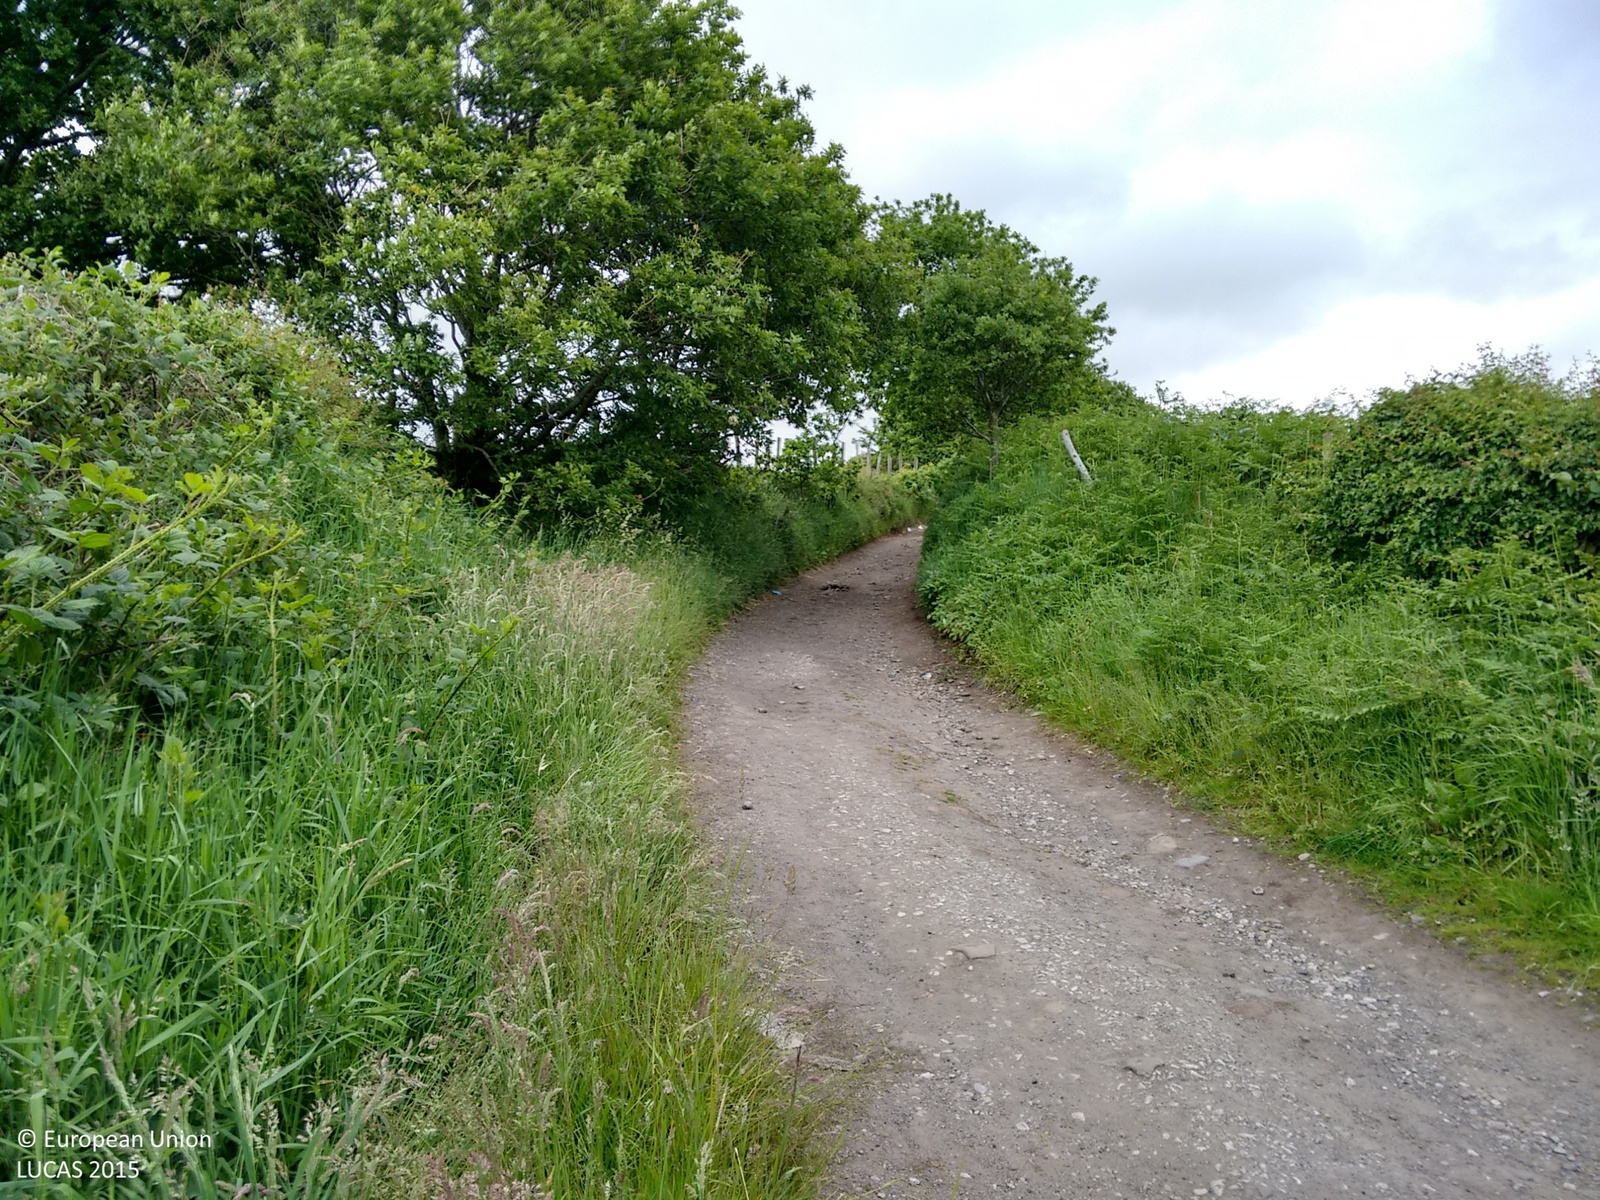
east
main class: Grassland
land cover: Grassland without tree/shrub cover
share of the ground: > 75 %
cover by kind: herbaceous plants 100 %
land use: Agriculture (excluding fallow land and kitchen gardens)
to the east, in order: Grassland without tree/shrub cover; Single bushes/trees; Grassland without tree/shrub cover; Fences; Grass margins; Lines of trees; Tracks; Grass margins; Managed hedges; Fences; Grassland without tree/shrub cover; Fences; Grass margins; Tracks; Single bushes/trees; Grass margins; Fences; Grassland with sparse tree/shrub cover
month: June
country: GB
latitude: 53.5691
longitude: -2.1549
